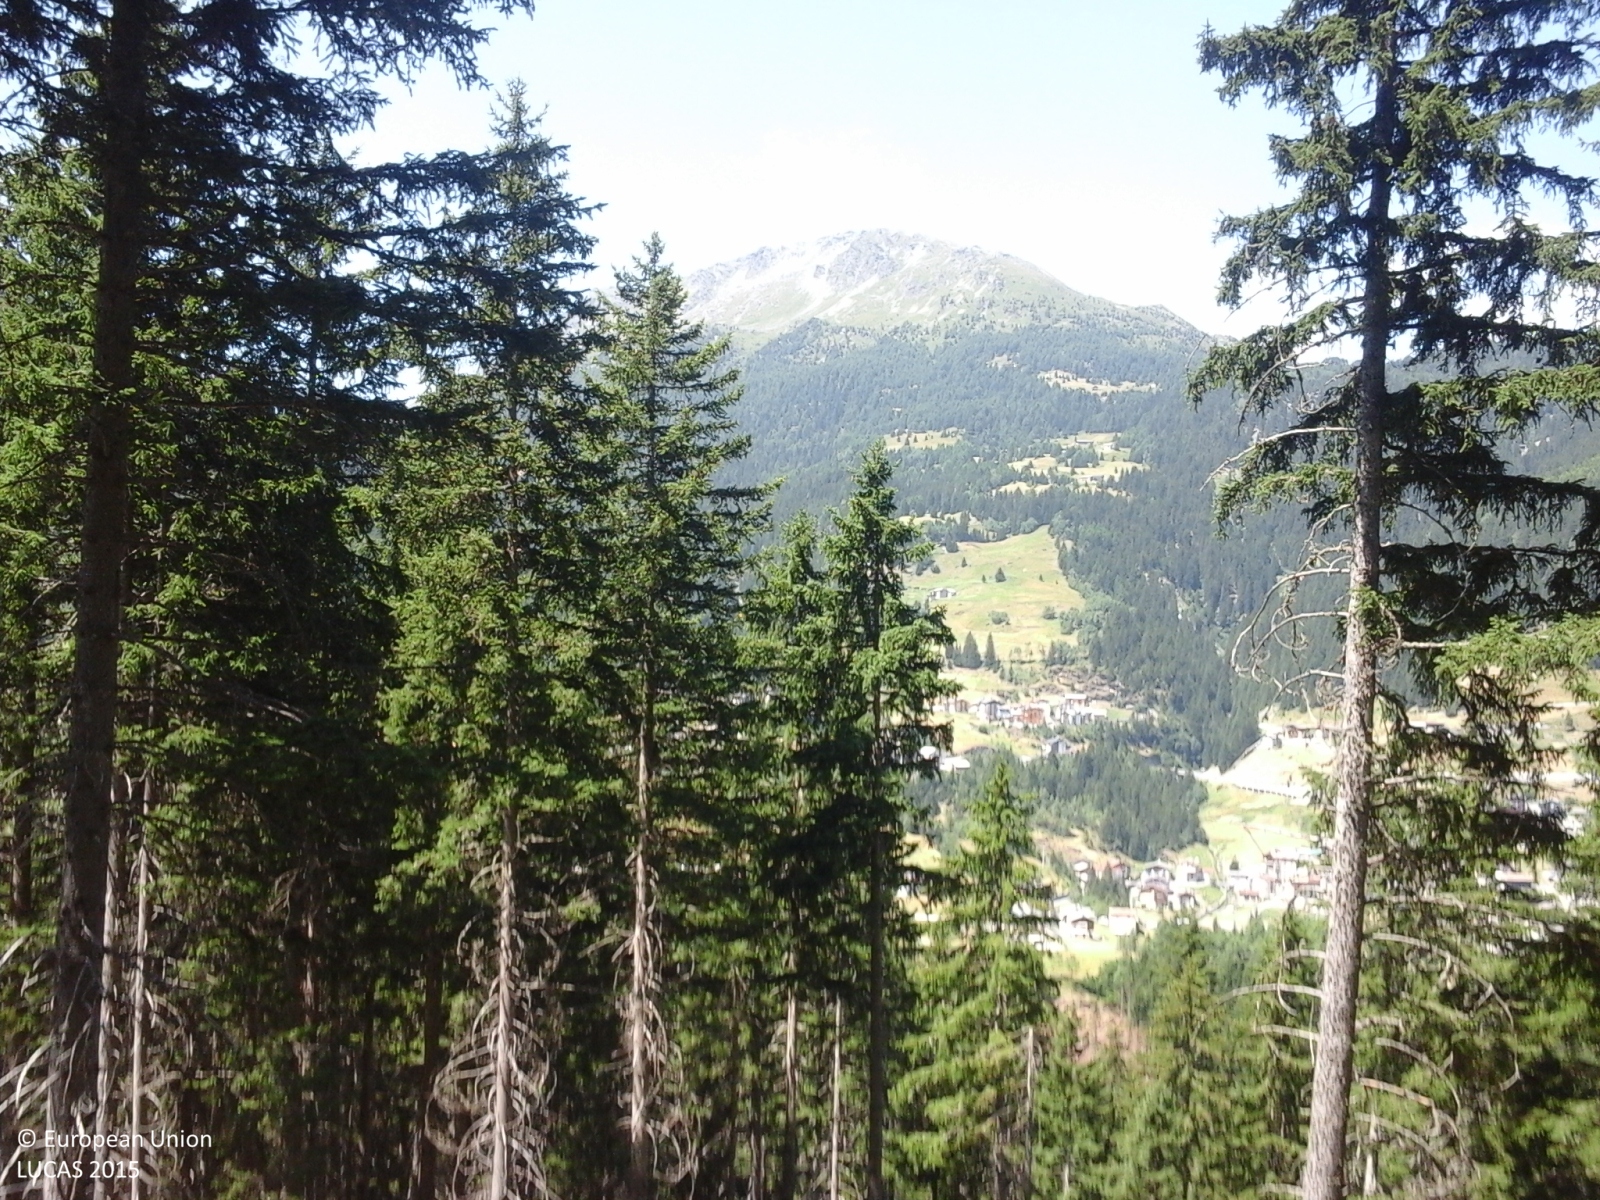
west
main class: Woodland
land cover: Spruce dominated coniferous woodland
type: alpine coniferous forest
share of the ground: > 75 %
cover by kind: coniferous forest trees 100 %
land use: Forestry
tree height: > 5 m
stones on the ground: 10 - 25 %
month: July
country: IT
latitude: 46.4769
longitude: 10.2732
